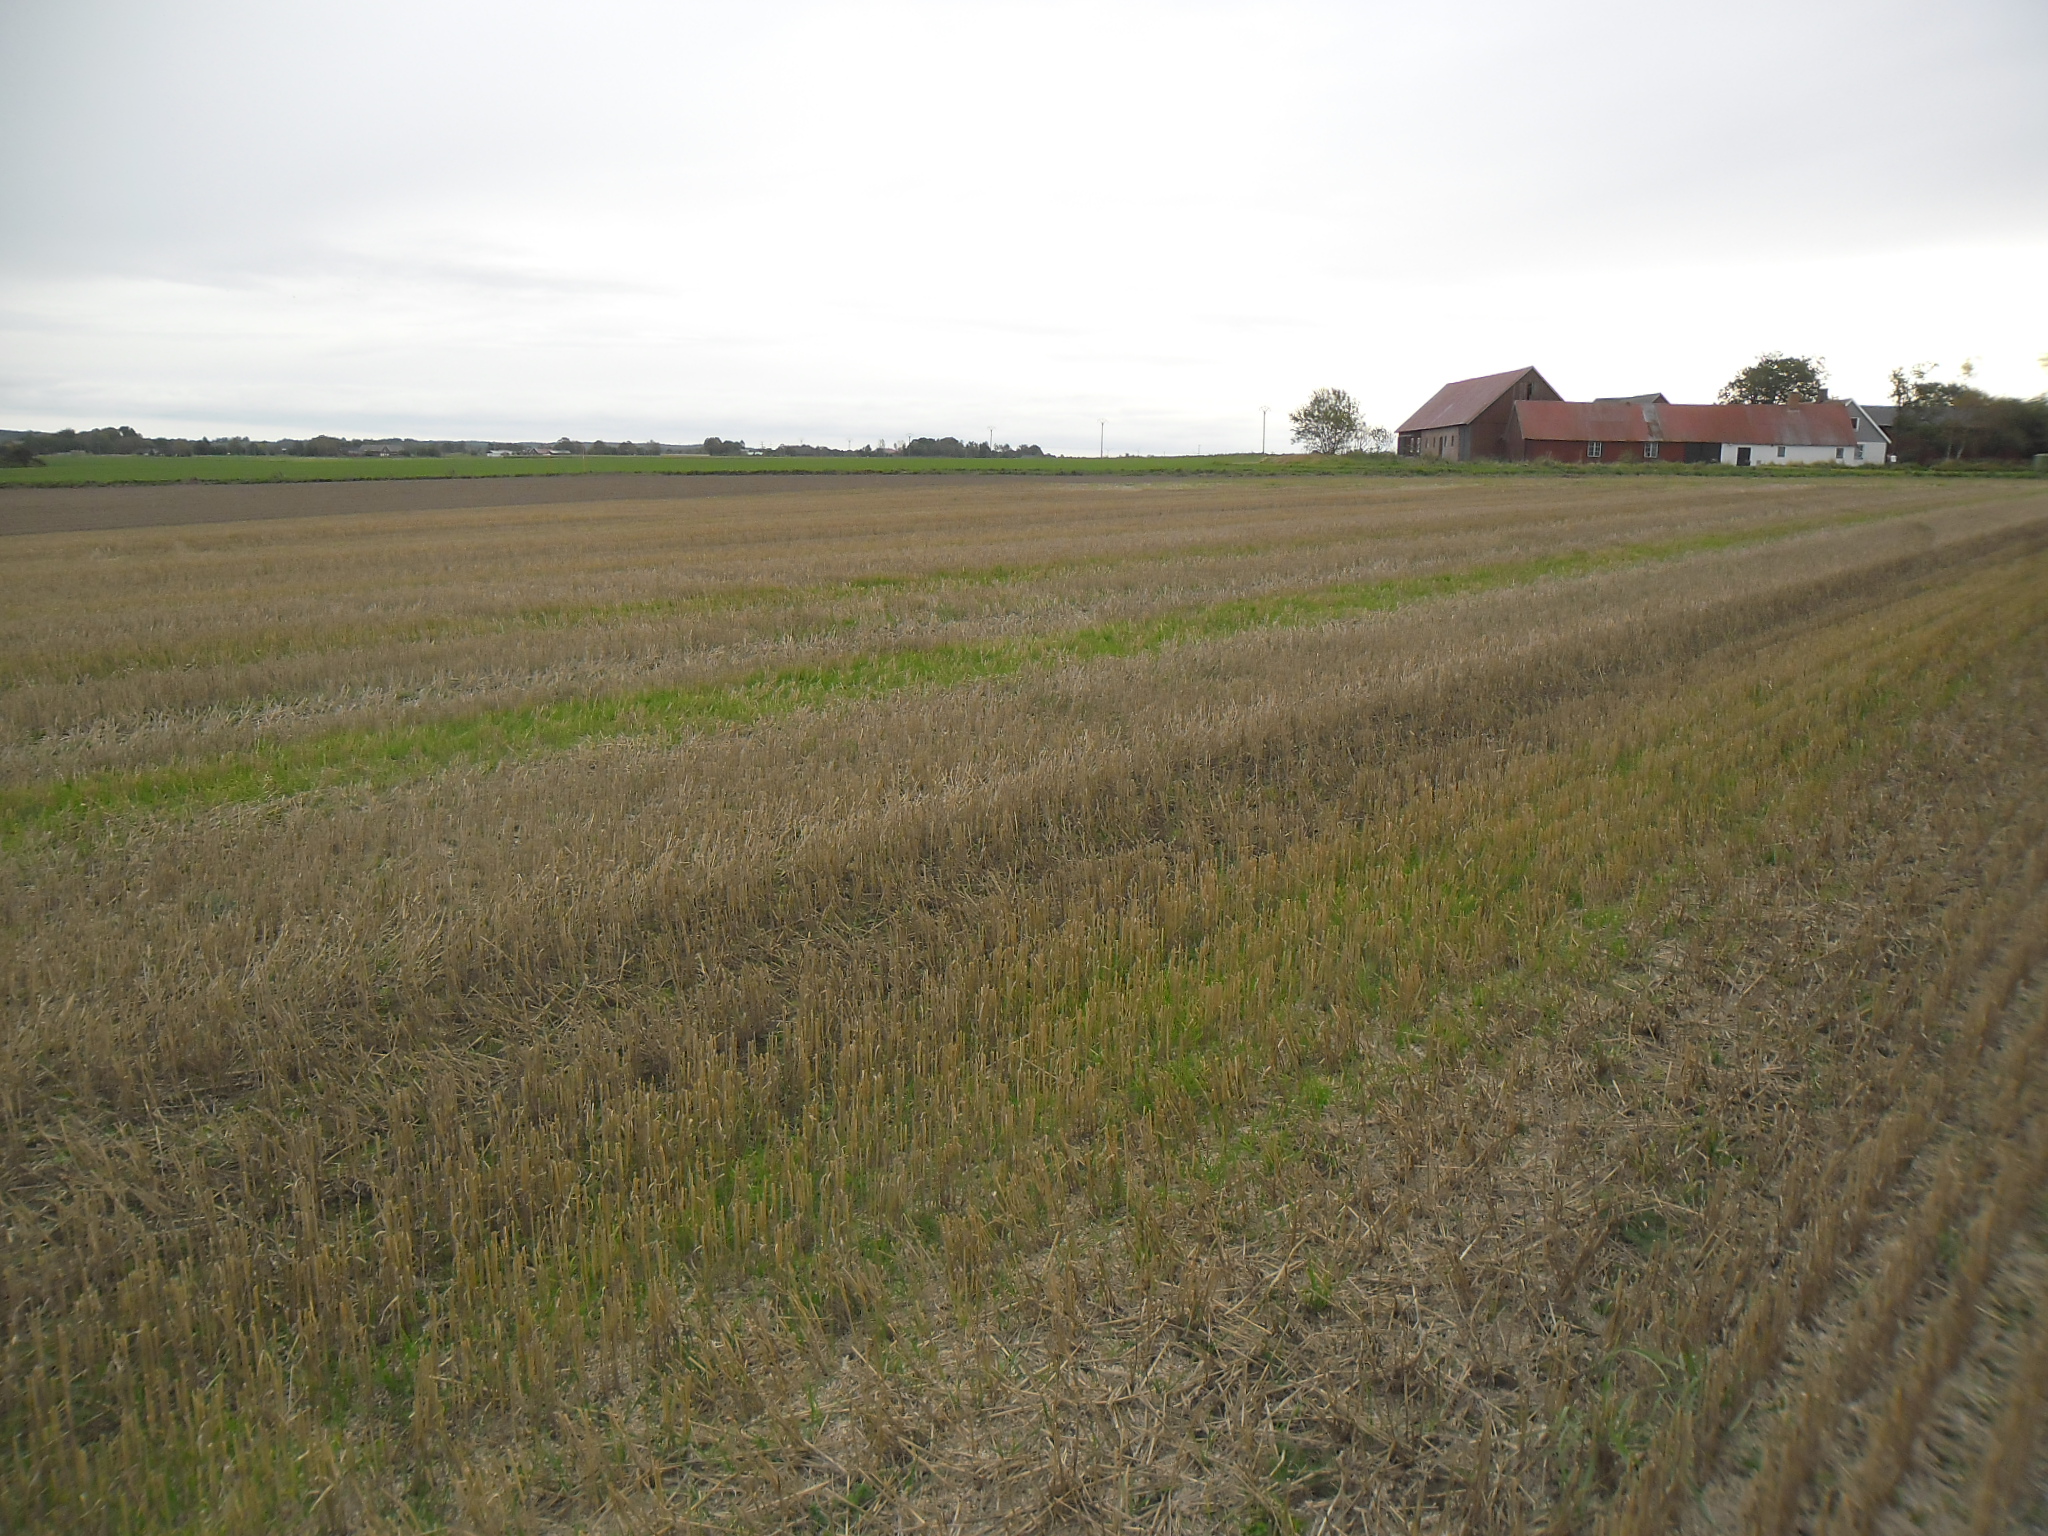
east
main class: Cropland
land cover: Common wheat
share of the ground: 10 - 25 %
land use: Agriculture (excluding fallow land and kitchen gardens)
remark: Harvested field
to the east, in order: Common wheat; Grass margins; Paved roads, cycling and walking lanes; Grass margins; Common wheat
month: October
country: SE
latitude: 56.4743
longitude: 13.0978
